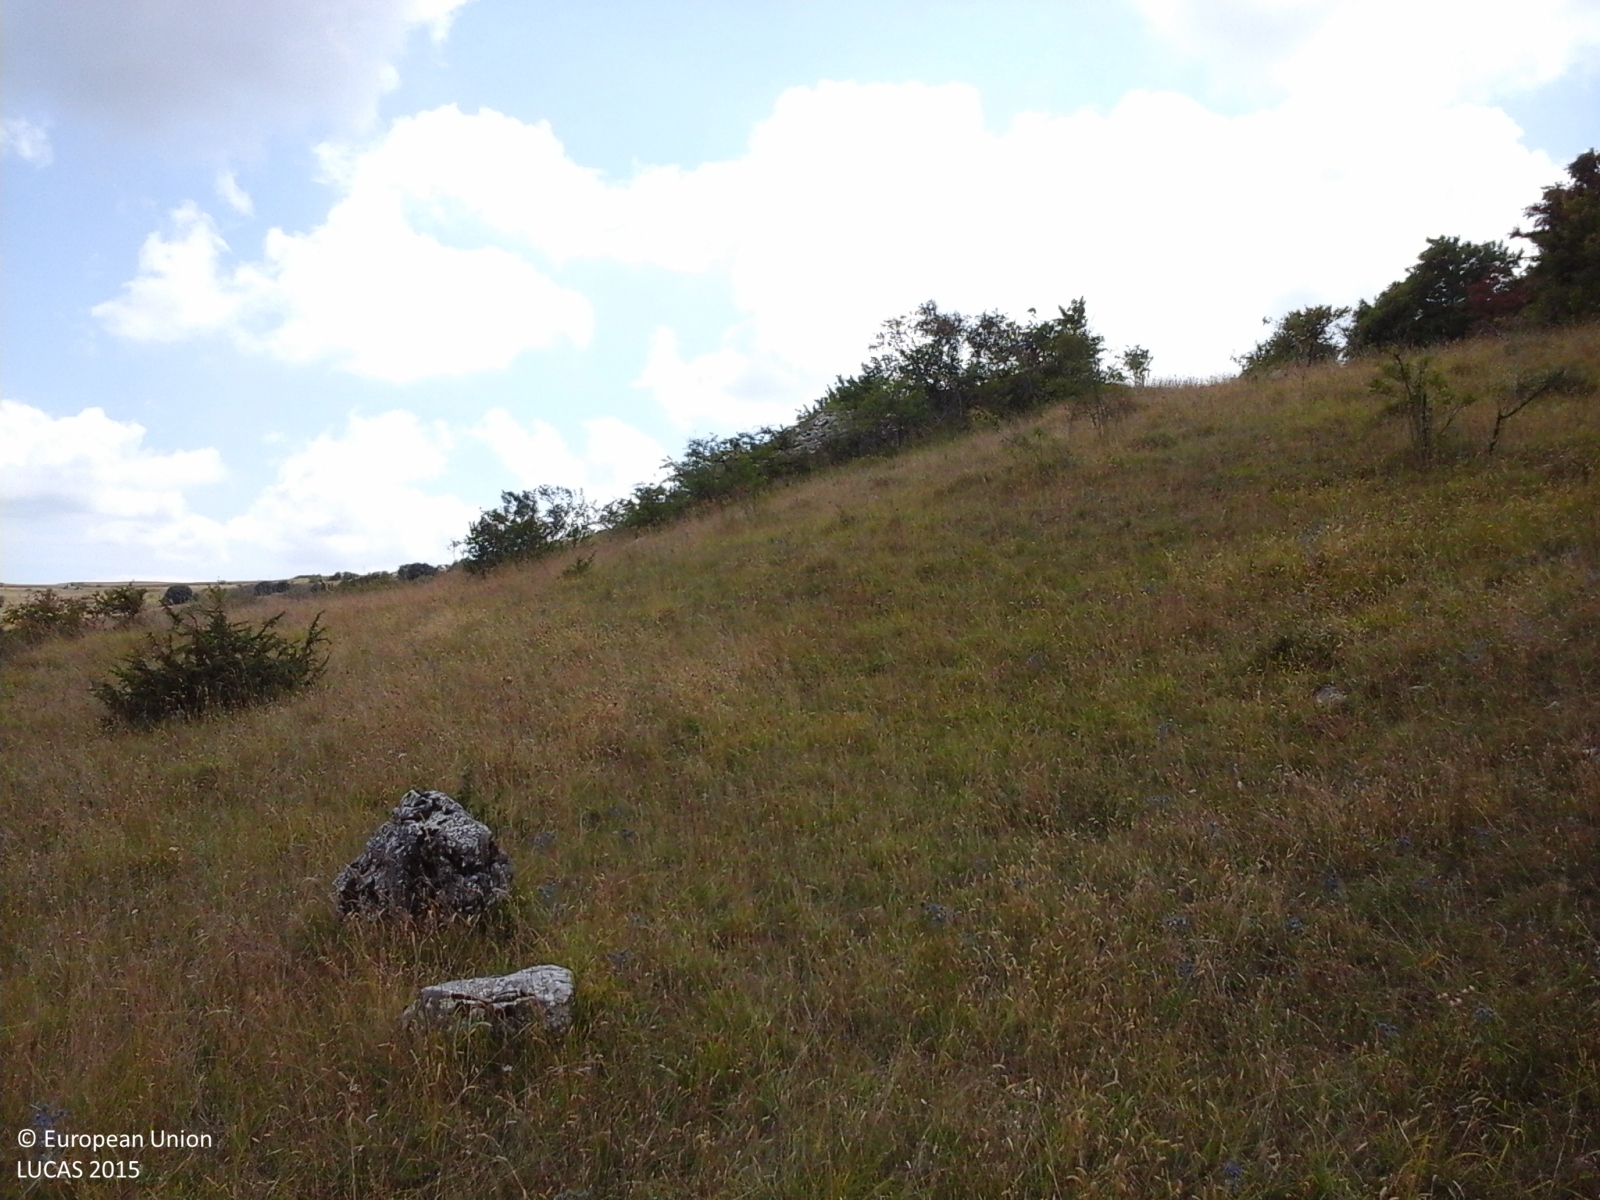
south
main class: Shrubland
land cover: Shrubland with sparse tree cover
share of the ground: > 75 %
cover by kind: herbaceous plants 50 %, shrubs 45 %, broadleaved forest trees 5 %
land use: Semi-natural and natural areas not in use
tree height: < 5 m
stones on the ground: 10 - 25 %
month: August
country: IT
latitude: 41.8037
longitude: 14.2822
